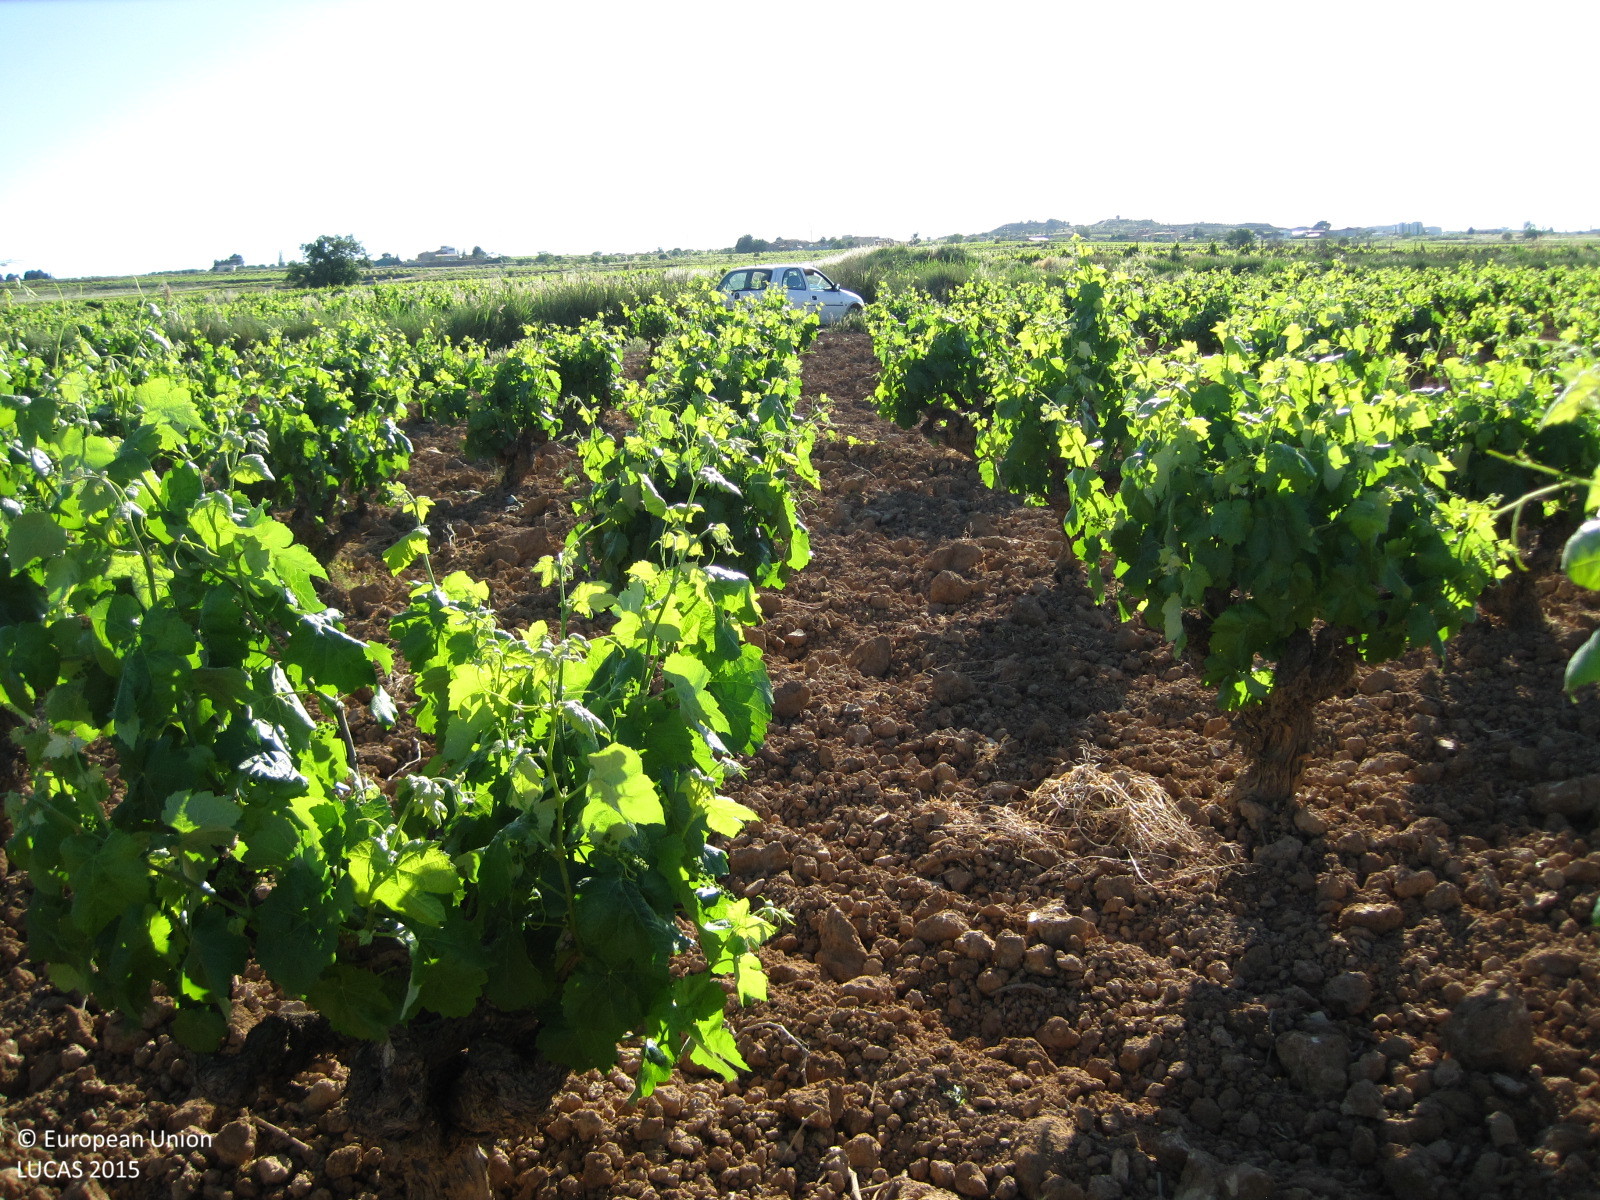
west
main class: Cropland
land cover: Vineyards
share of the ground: 25 - 50 %
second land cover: Other bare soil
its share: > 75 %
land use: Agriculture (excluding fallow land and kitchen gardens)
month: May
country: ES
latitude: 39.4862
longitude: -1.1281
